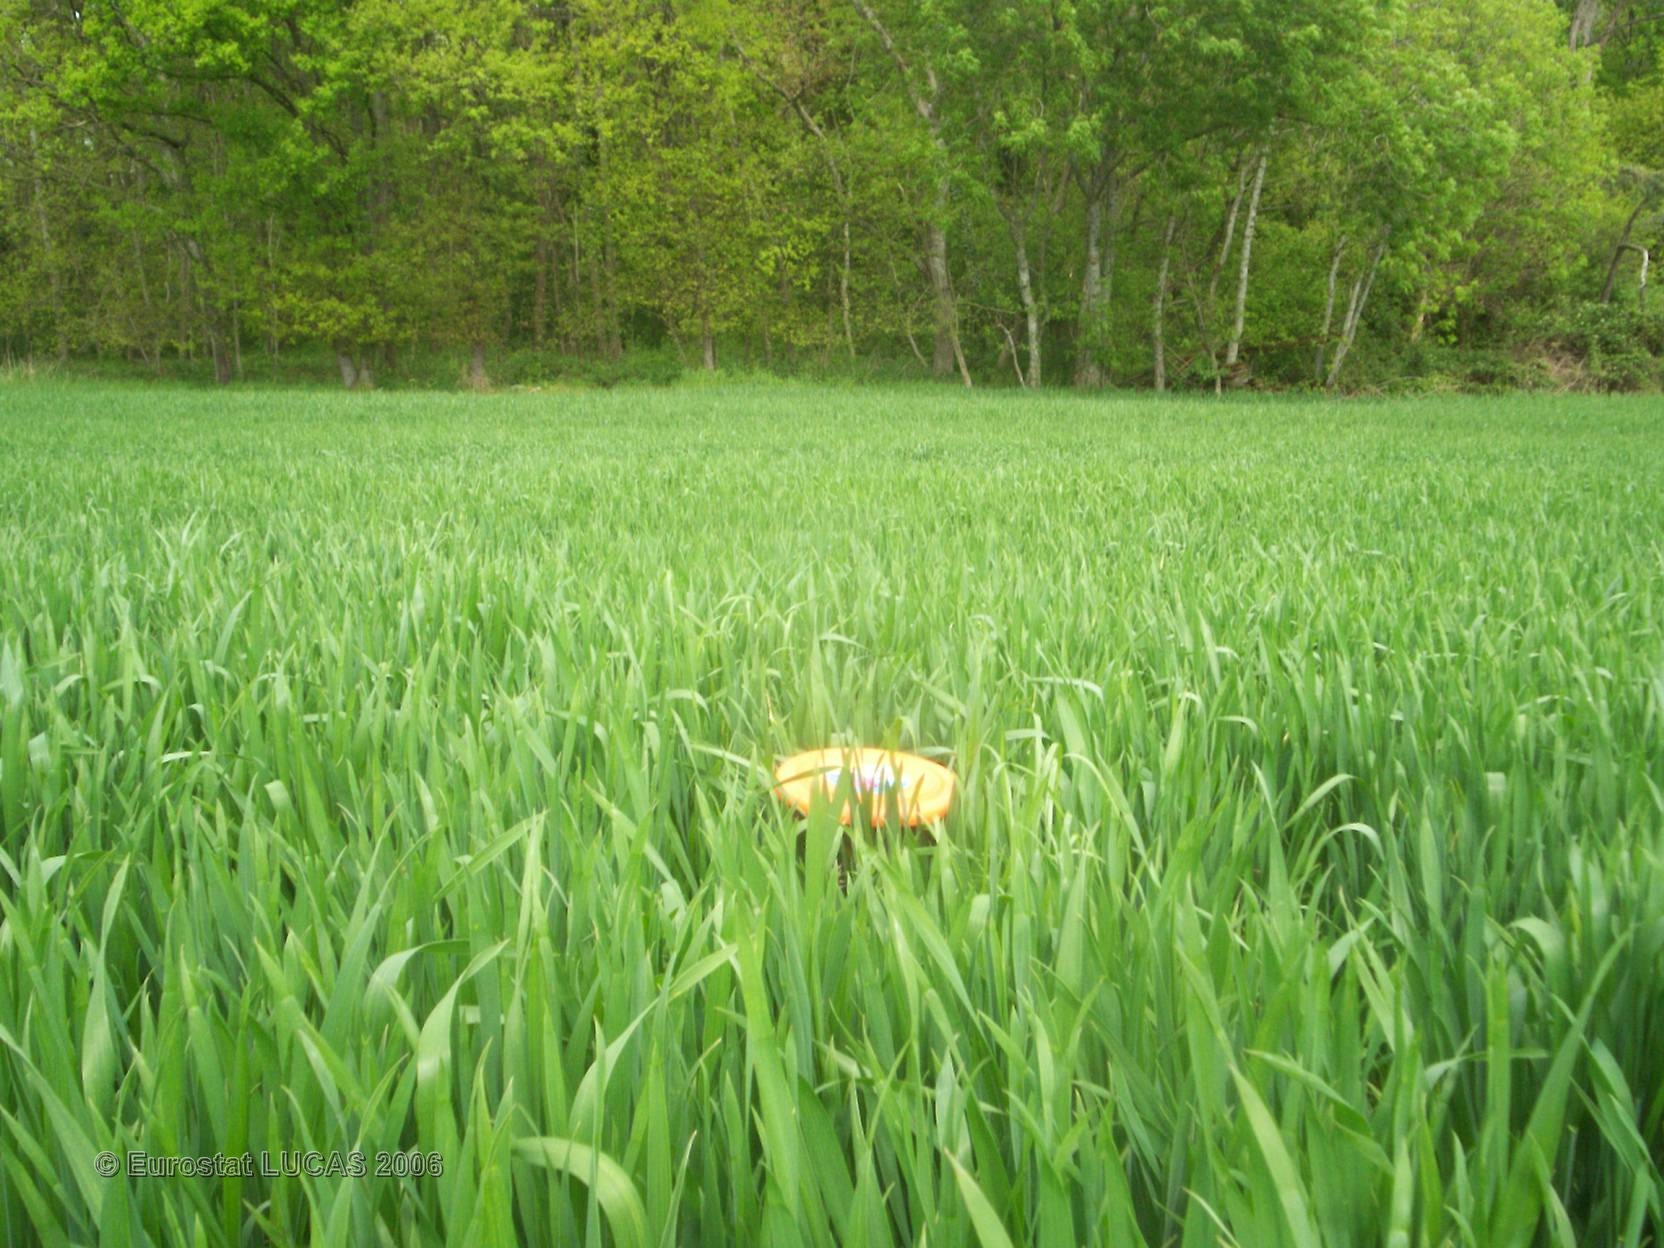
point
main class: Cropland
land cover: Common wheat
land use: Agriculture (excluding fallow land and kitchen gardens)
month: May
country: FR
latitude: 46.2441
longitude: 3.2156
